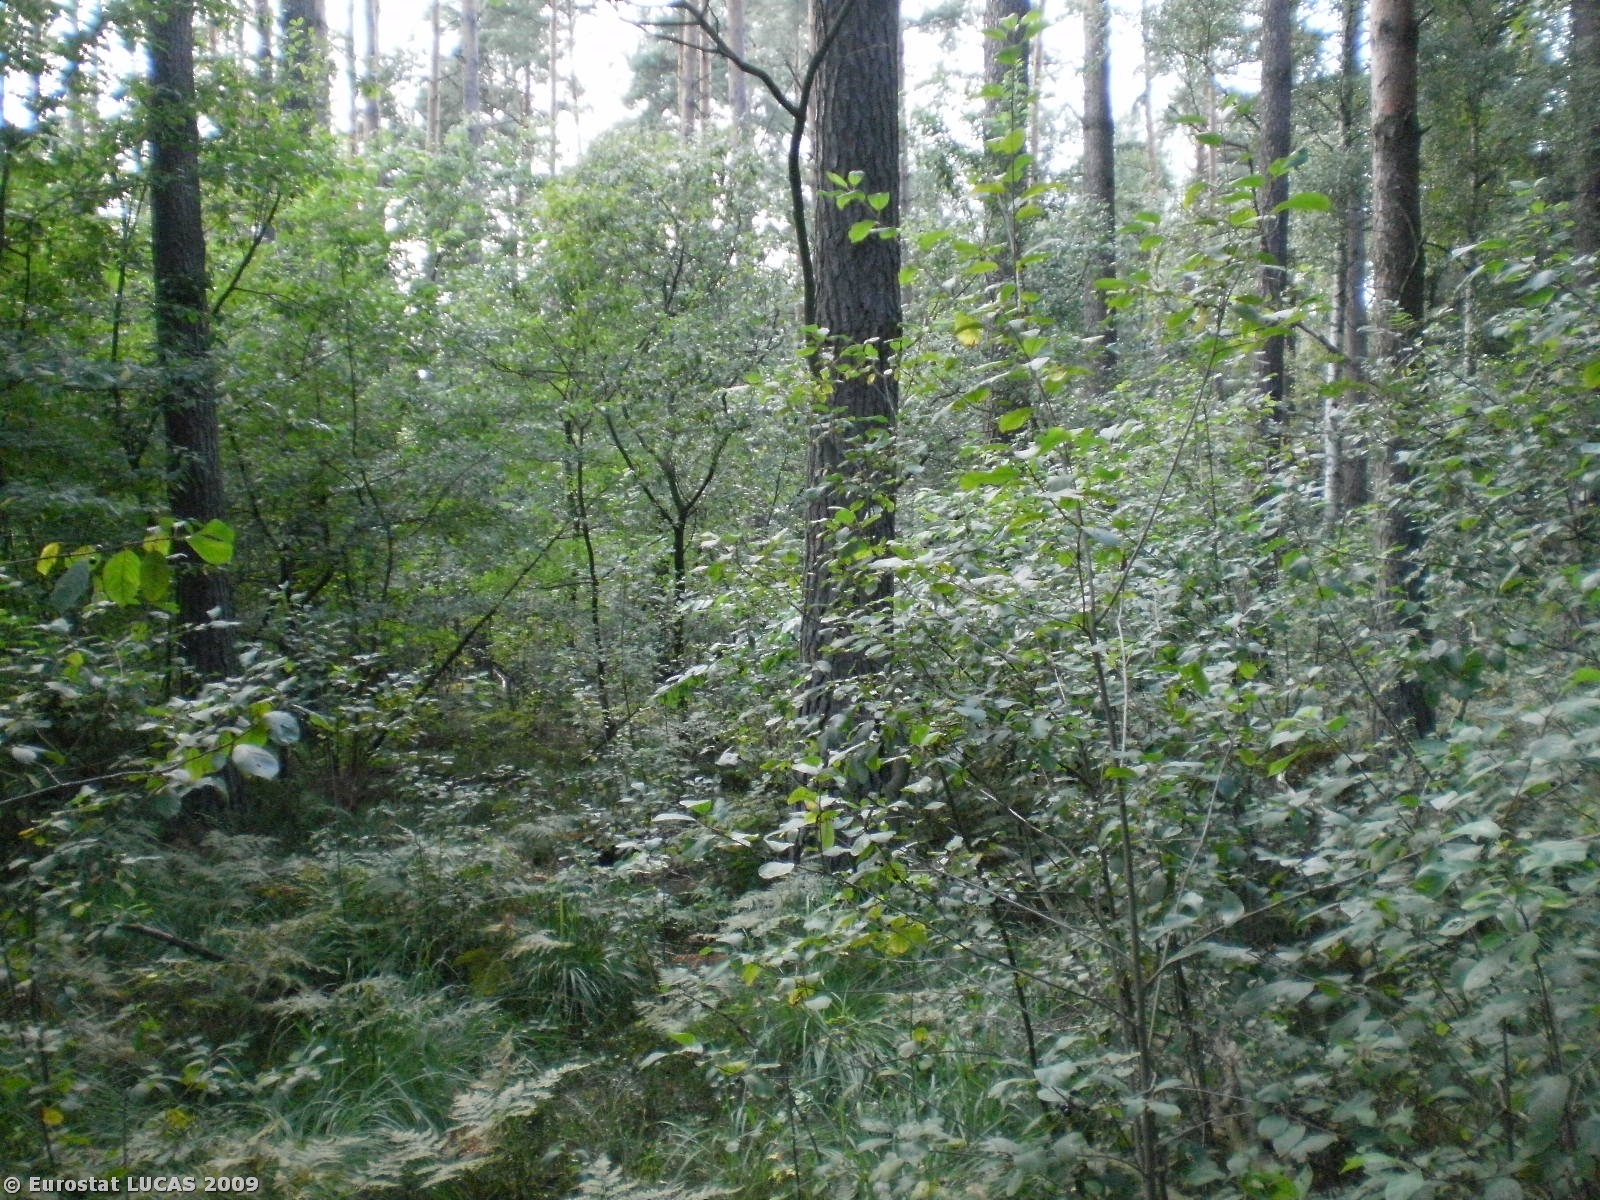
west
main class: Woodland
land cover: Mixed woodland
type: hemiboreal forest and nemoral coniferous forest and mixed broadleaved-coniferous forest
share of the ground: > 75 %
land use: Forestry
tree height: > 5 m
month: August
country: PL
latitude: 52.7672
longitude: 21.8082
